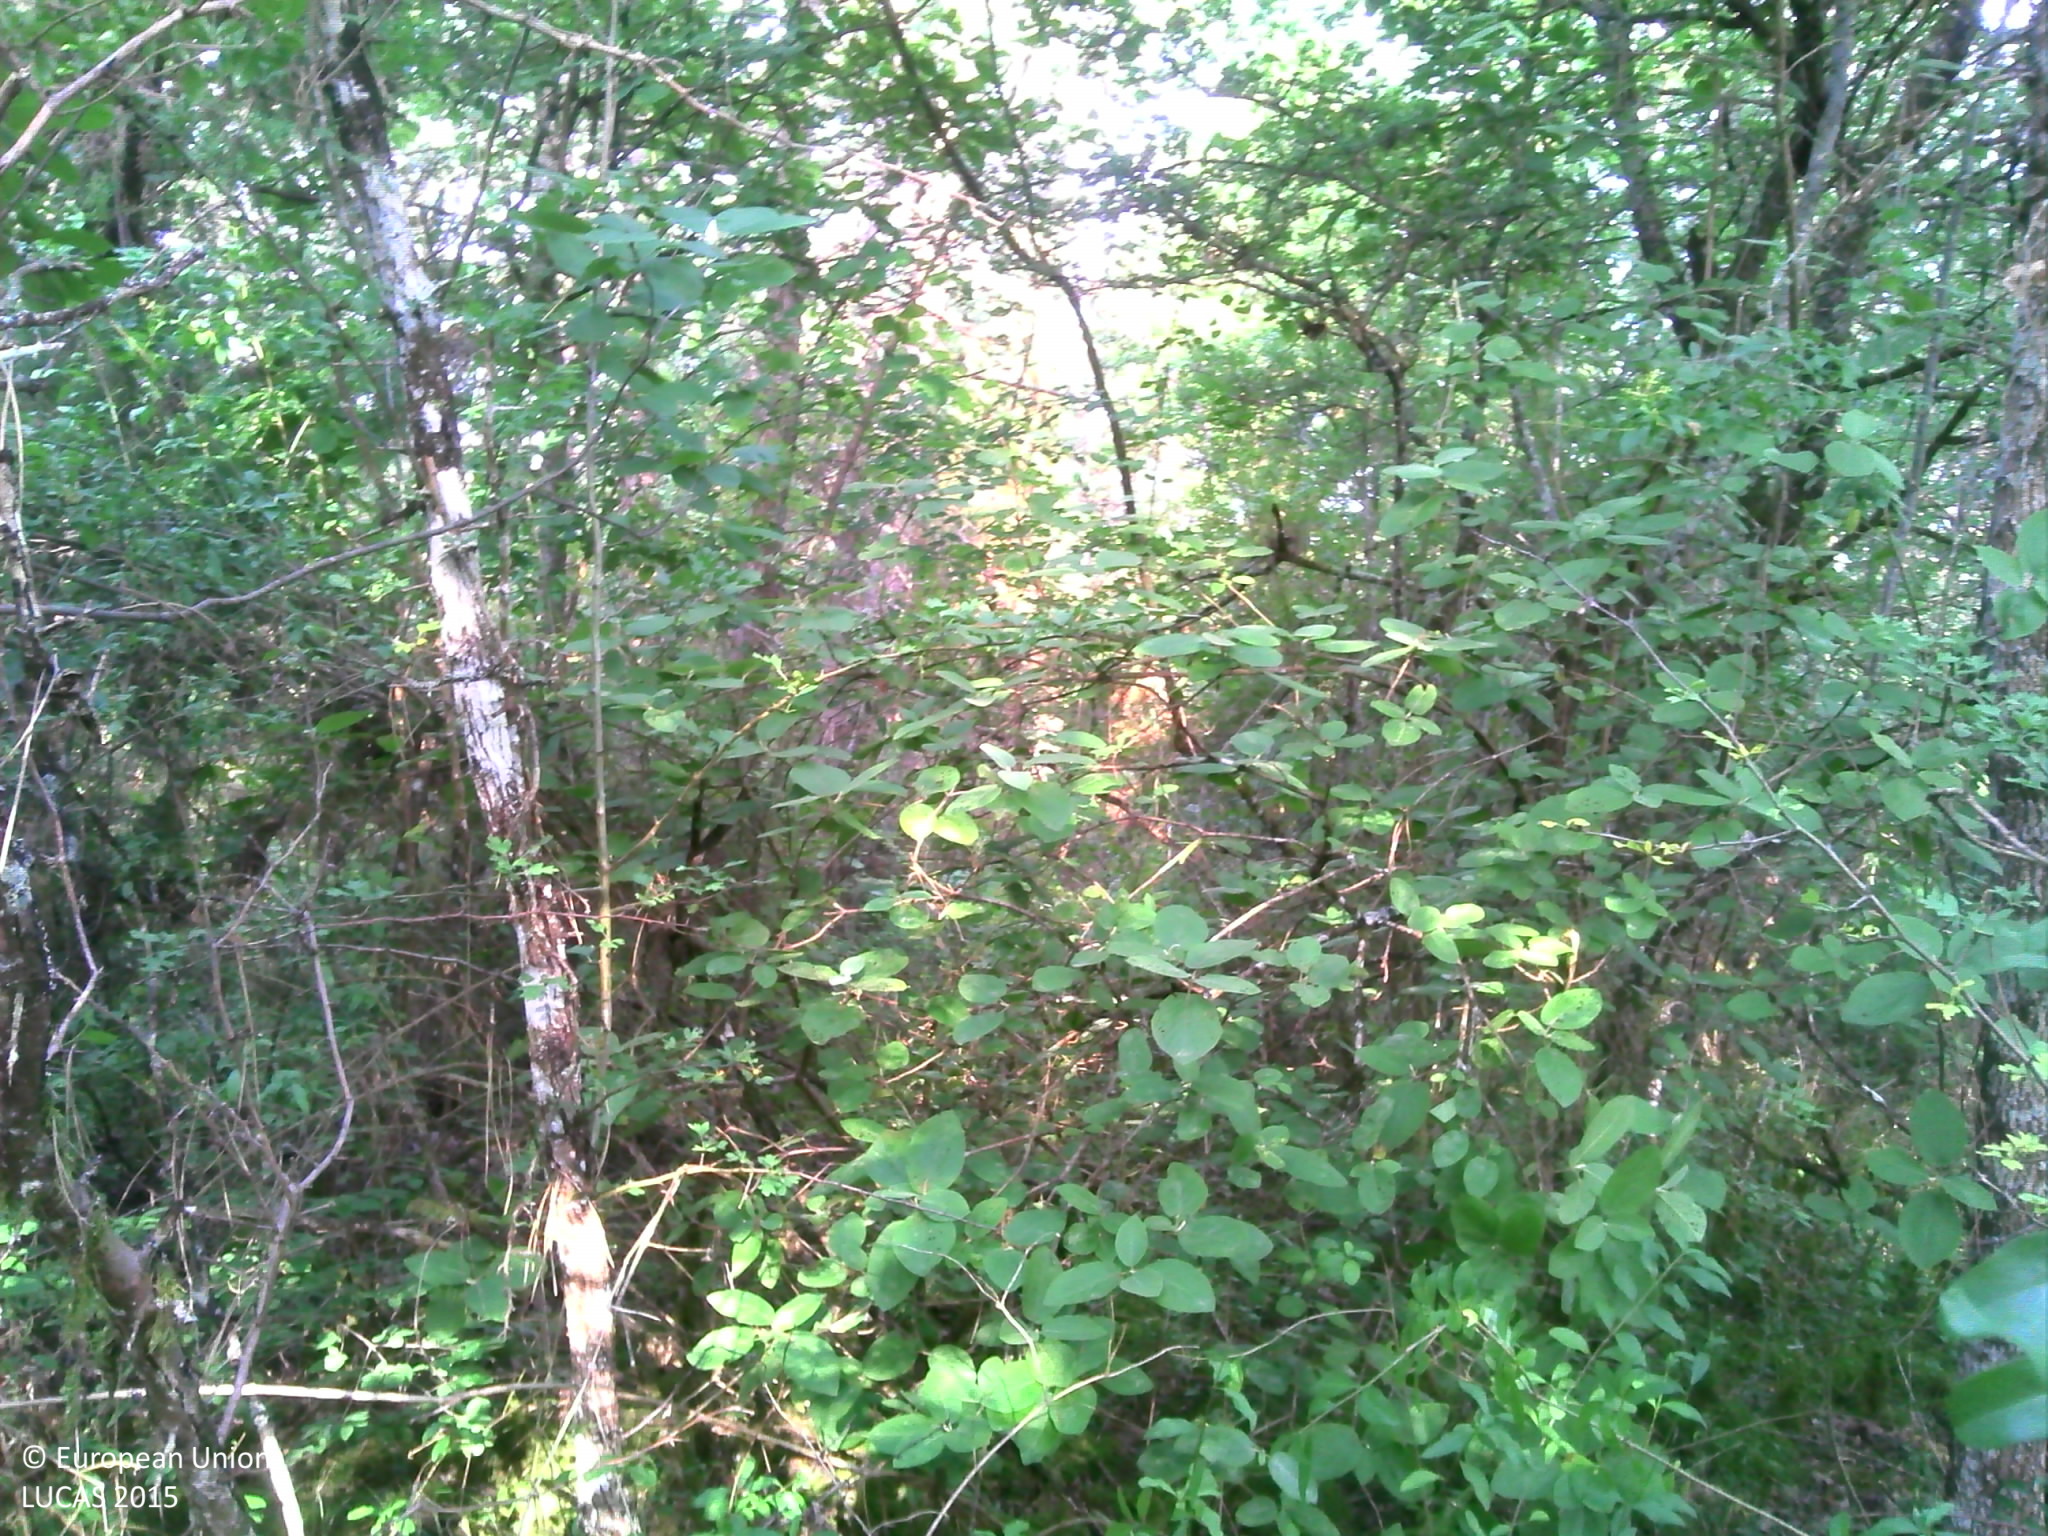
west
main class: Woodland
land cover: Pine dominated coniferous woodland
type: mesophytic deciduous forest
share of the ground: > 75 %
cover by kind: coniferous forest trees 80 %, broadleaved forest trees 10 %, herbaceous plants 5 %, lichens and mosses 5 %
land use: Semi-natural and natural areas not in use
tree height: > 5 m
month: July
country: FR
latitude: 47.6743
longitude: 3.5628
